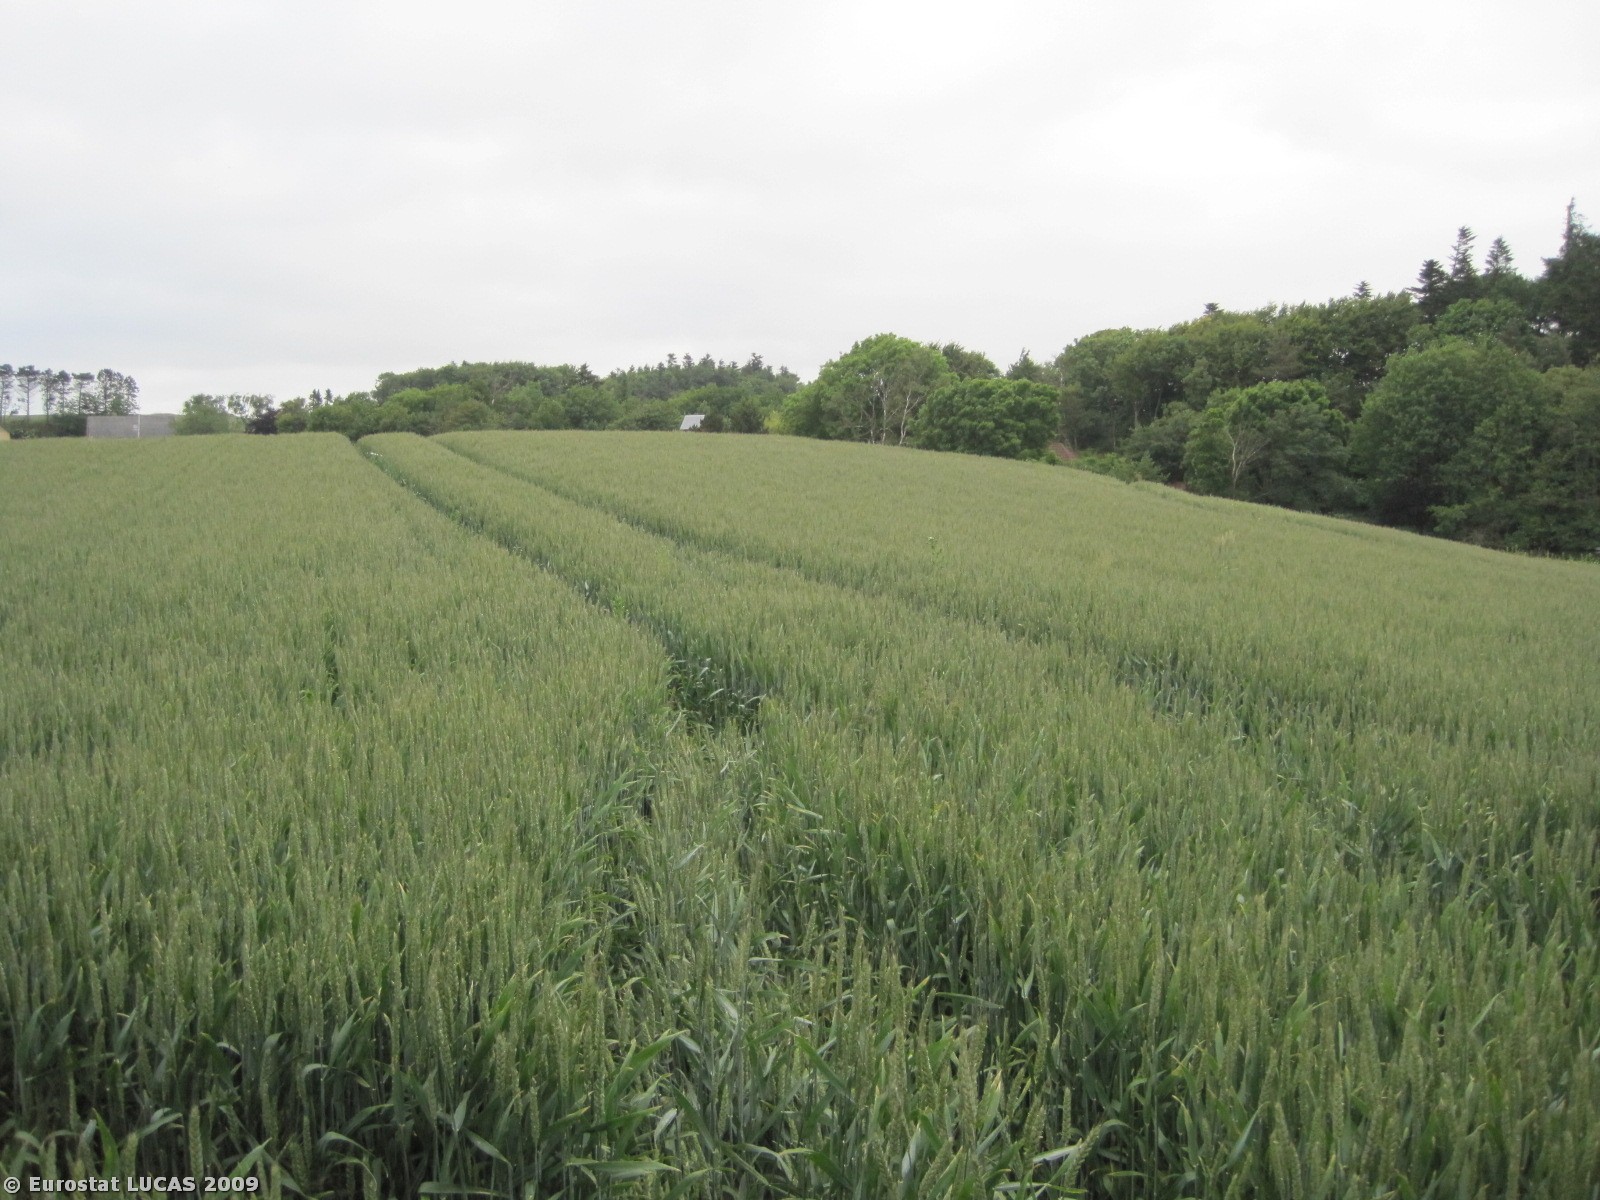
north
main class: Cropland
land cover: Common wheat
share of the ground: > 75 %
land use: Agriculture (excluding fallow land and kitchen gardens)
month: June
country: DK
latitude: 56.7392
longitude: 8.7755
